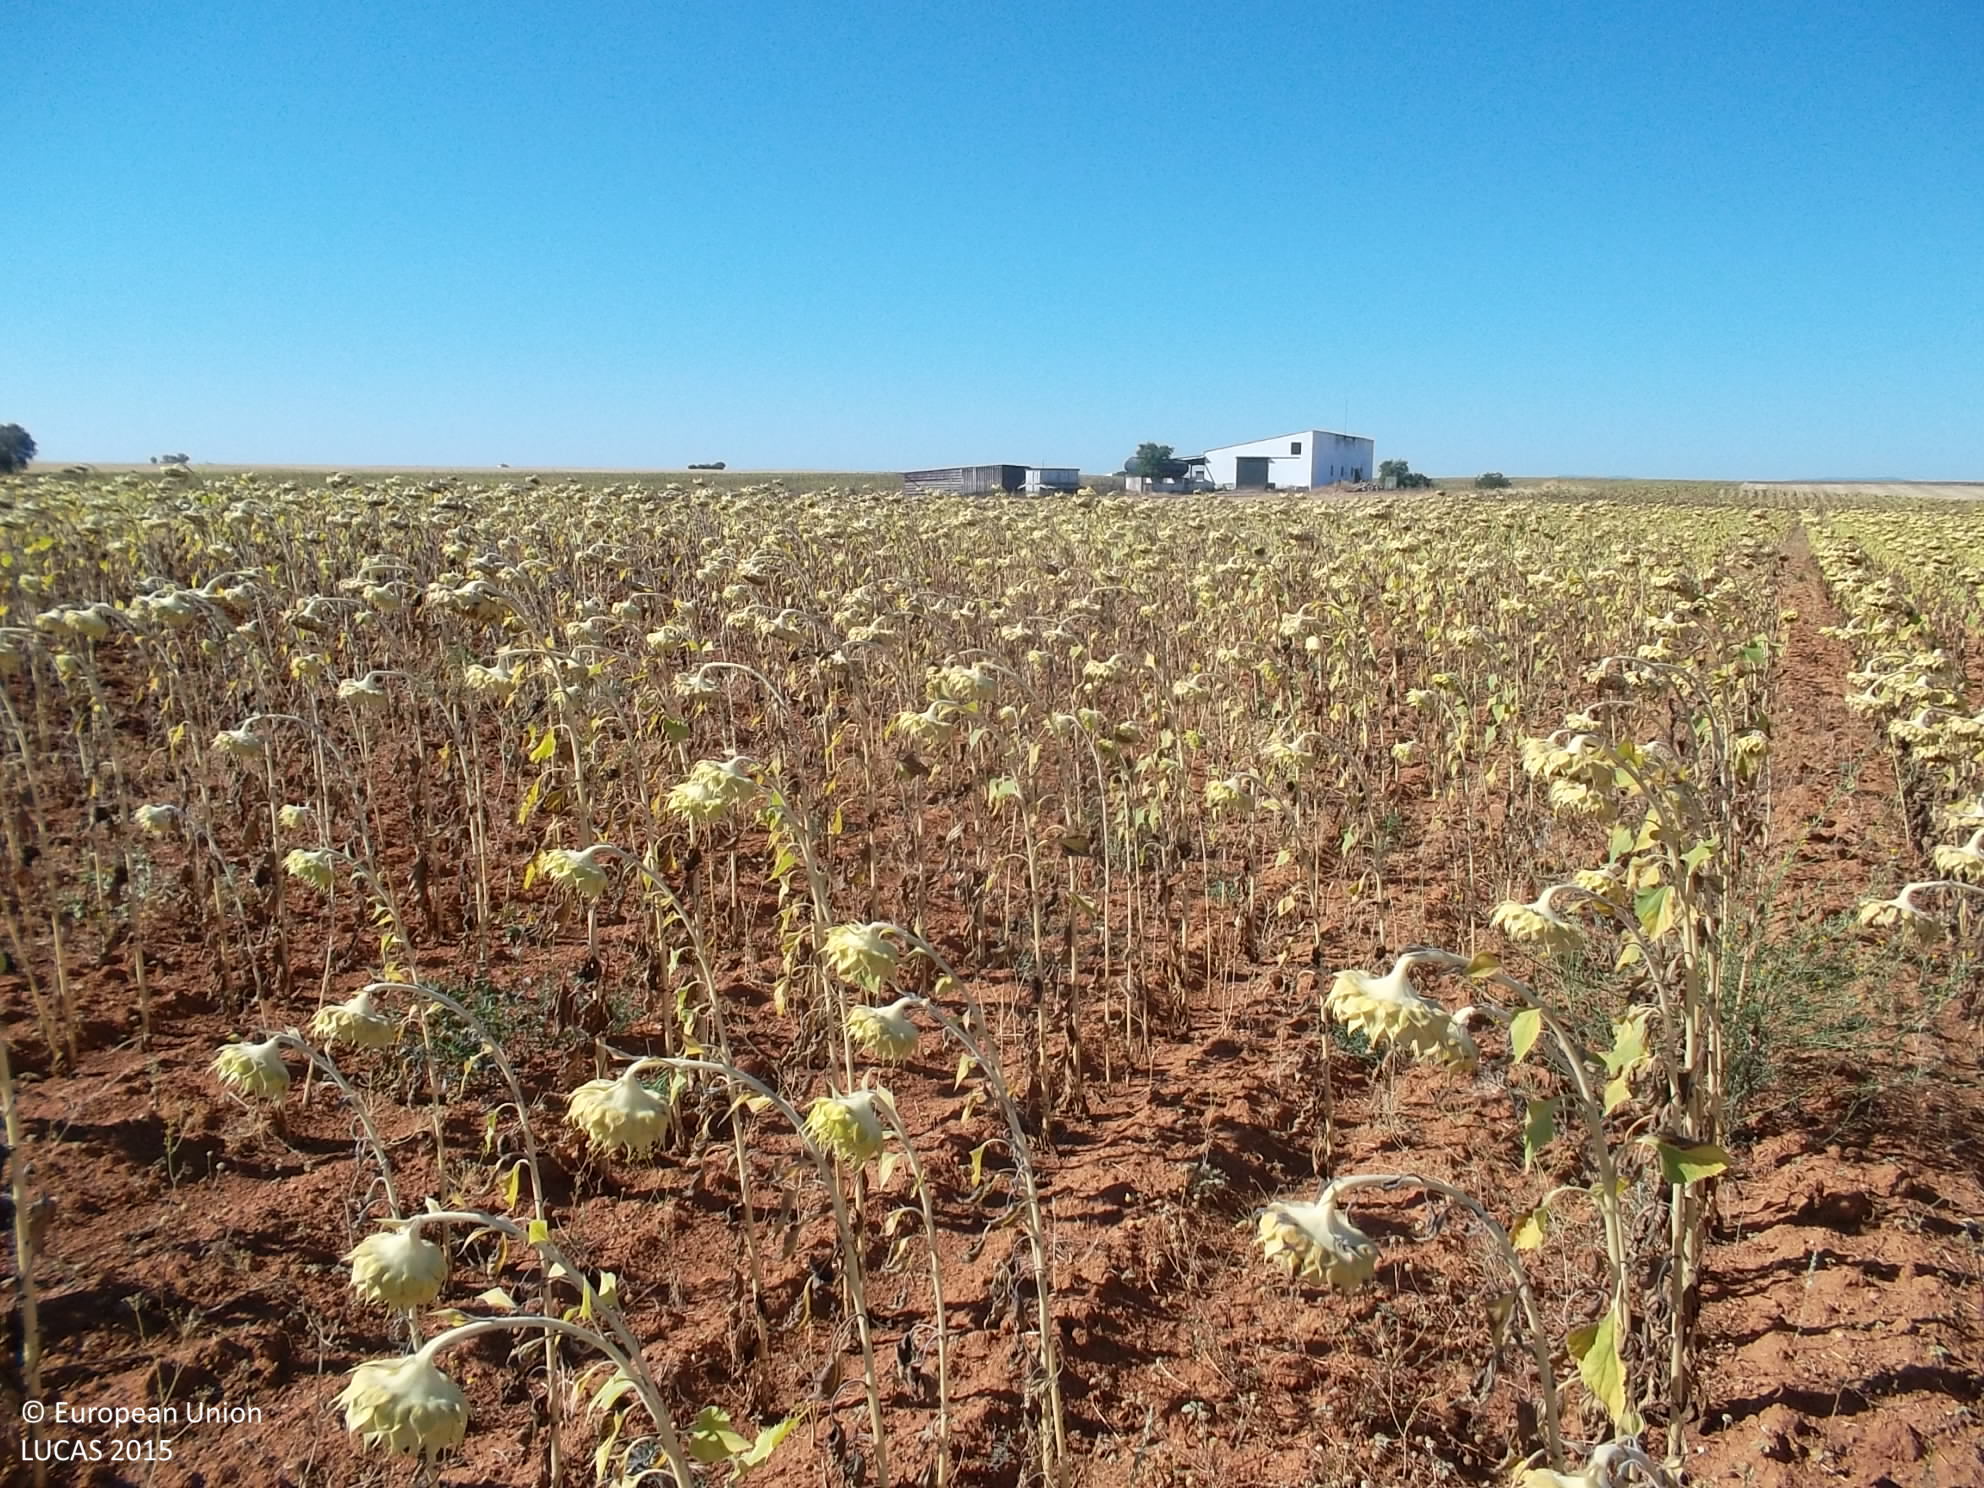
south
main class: Cropland
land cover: Sunflower
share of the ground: > 75 %
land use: Agriculture (excluding fallow land and kitchen gardens)
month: July
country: ES
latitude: 38.3819
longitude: -5.7320
